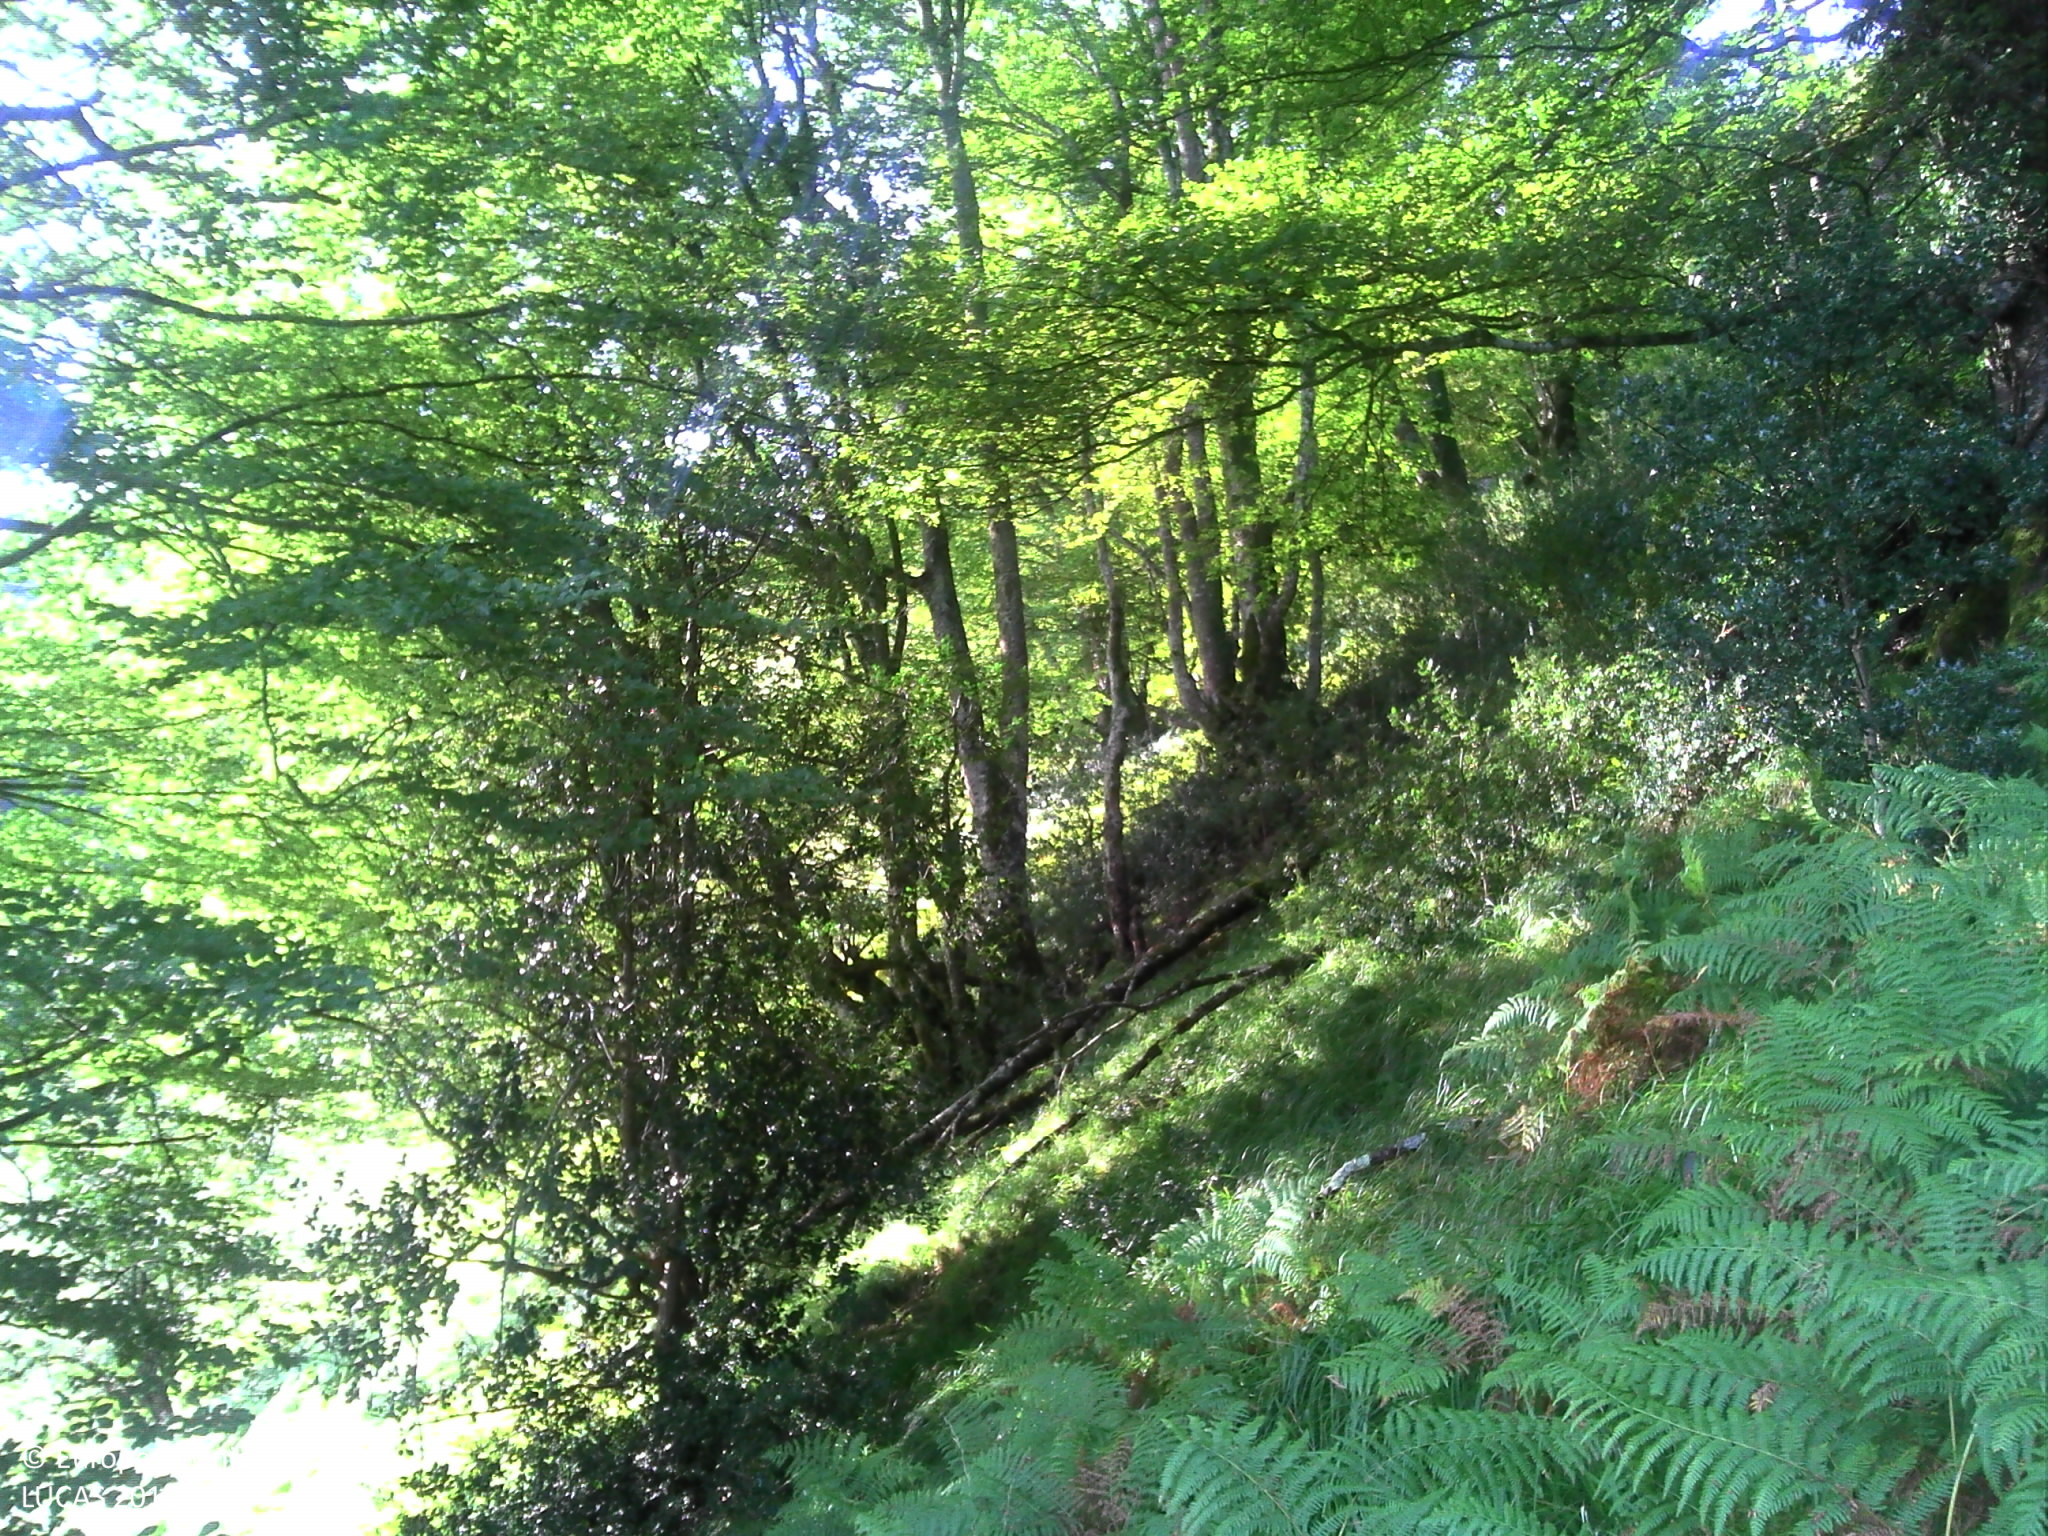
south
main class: Woodland
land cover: Broadleaved woodland
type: beech forest
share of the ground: 25 - 50 %
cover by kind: herbaceous plants 50 %, broadleaved forest trees 40 %, shrubs 10 %
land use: Forestry
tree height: > 5 m
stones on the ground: 10 - 25 %
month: September
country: FR
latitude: 43.0597
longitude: -0.9502
